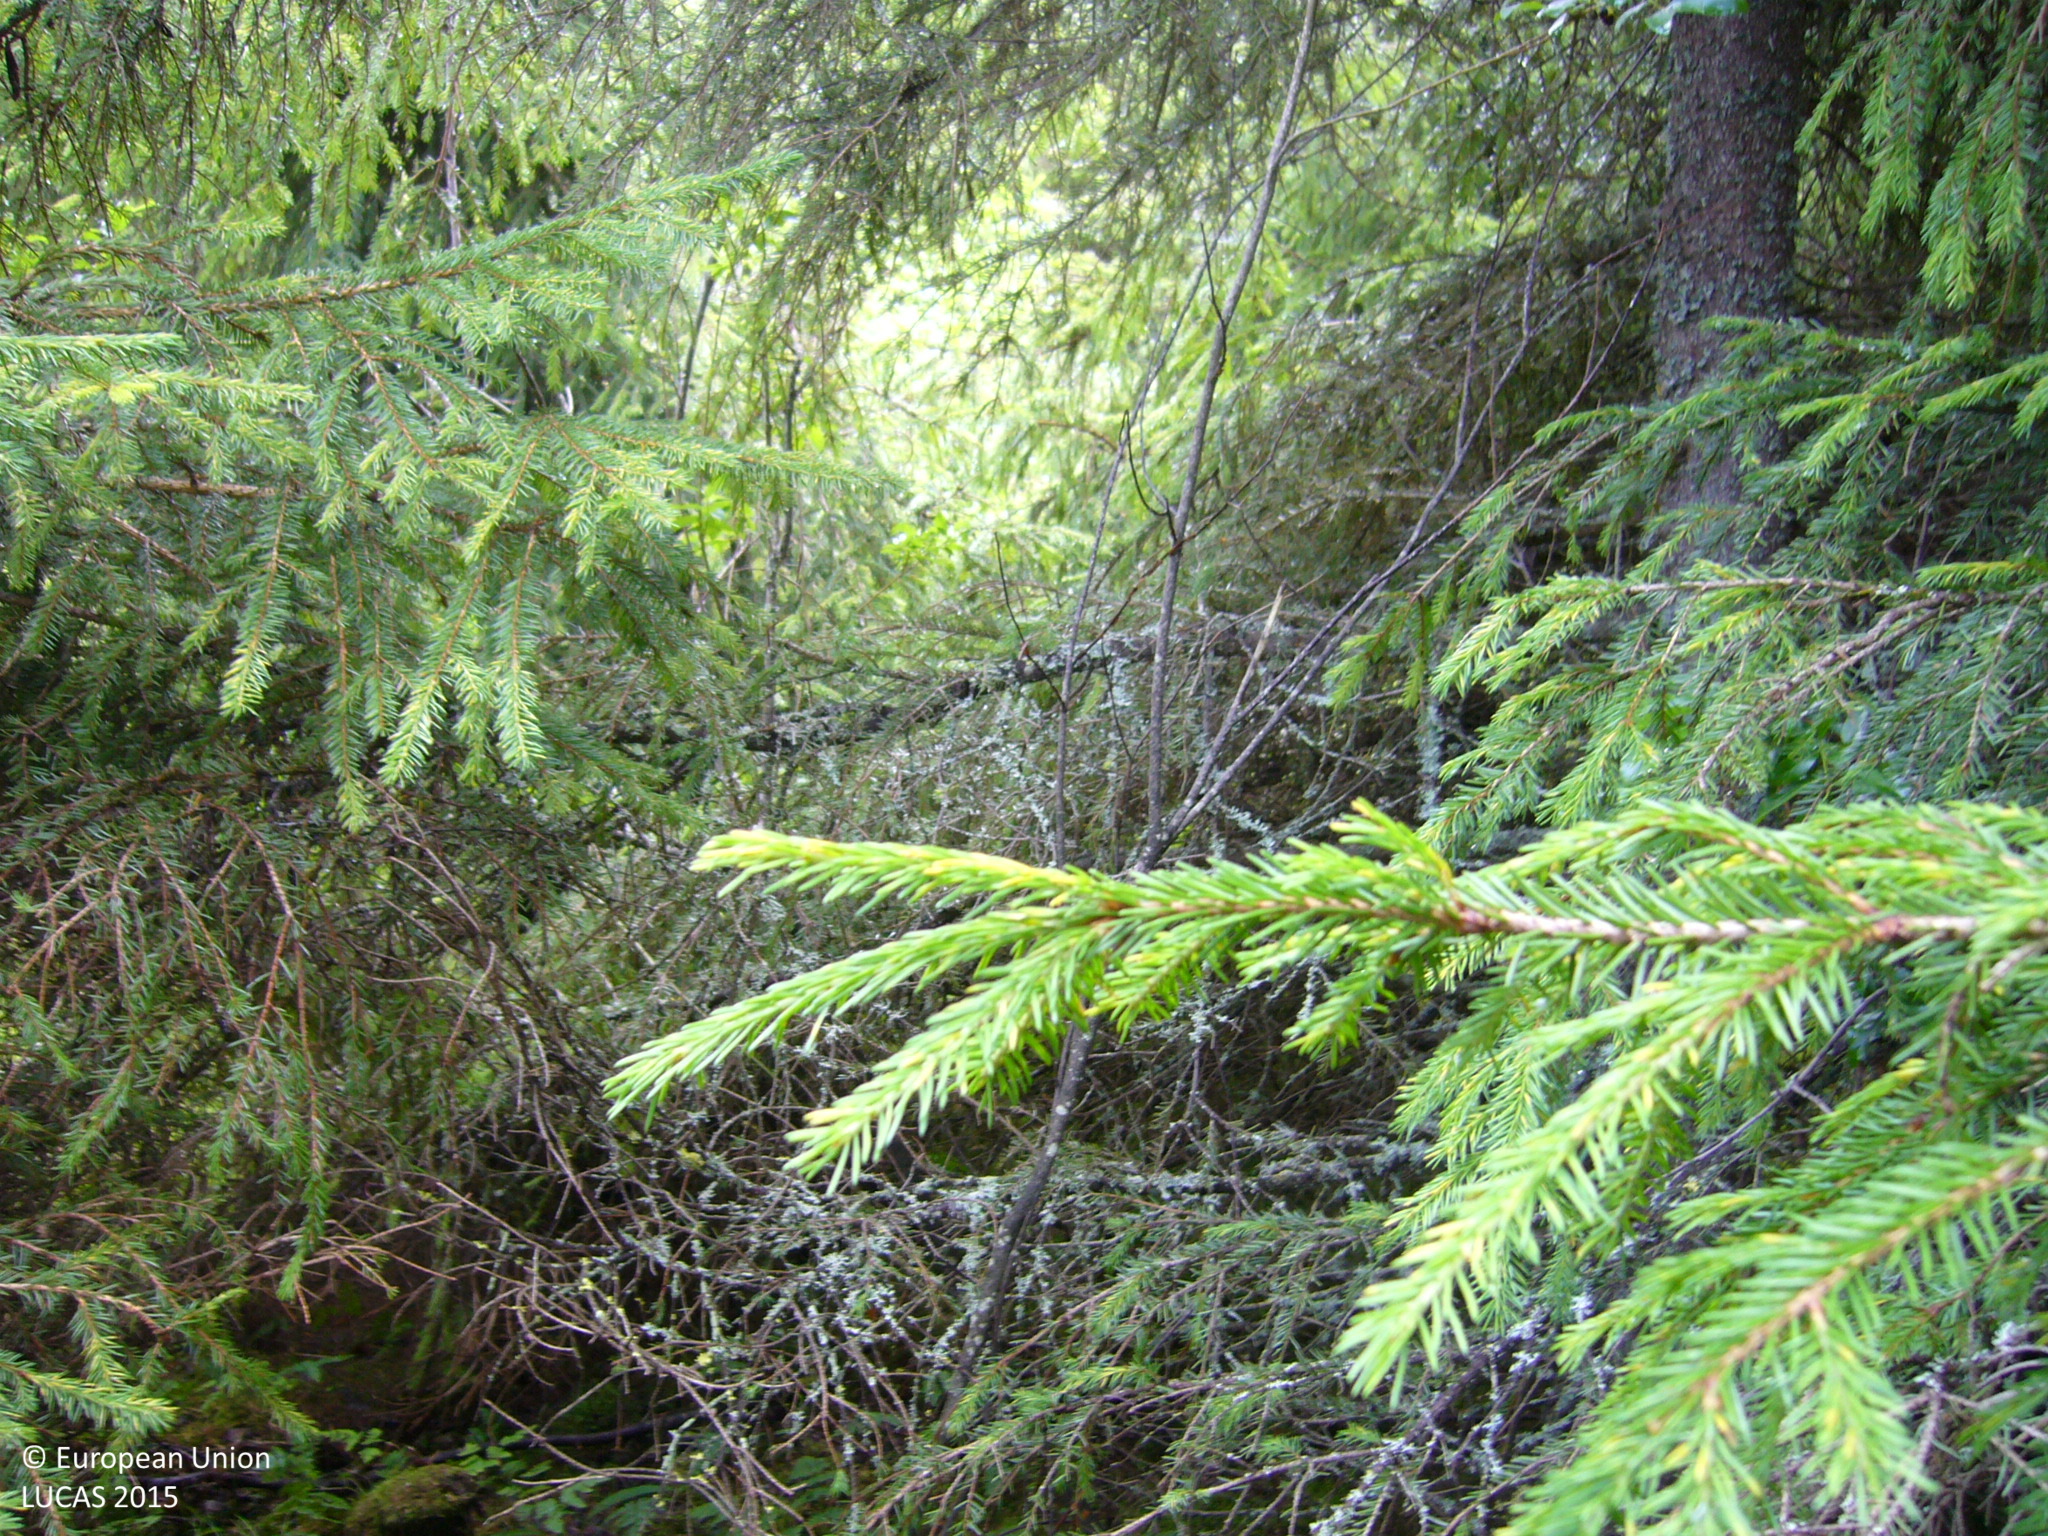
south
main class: Woodland
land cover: Spruce dominated mixed woodland
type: boreal forest
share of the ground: > 75 %
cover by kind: coniferous forest trees 70 %, broadleaved forest trees 25 %, shrubs 5 %
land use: Forestry
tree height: > 5 m
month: July
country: FI
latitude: 64.0096
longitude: 26.1254
